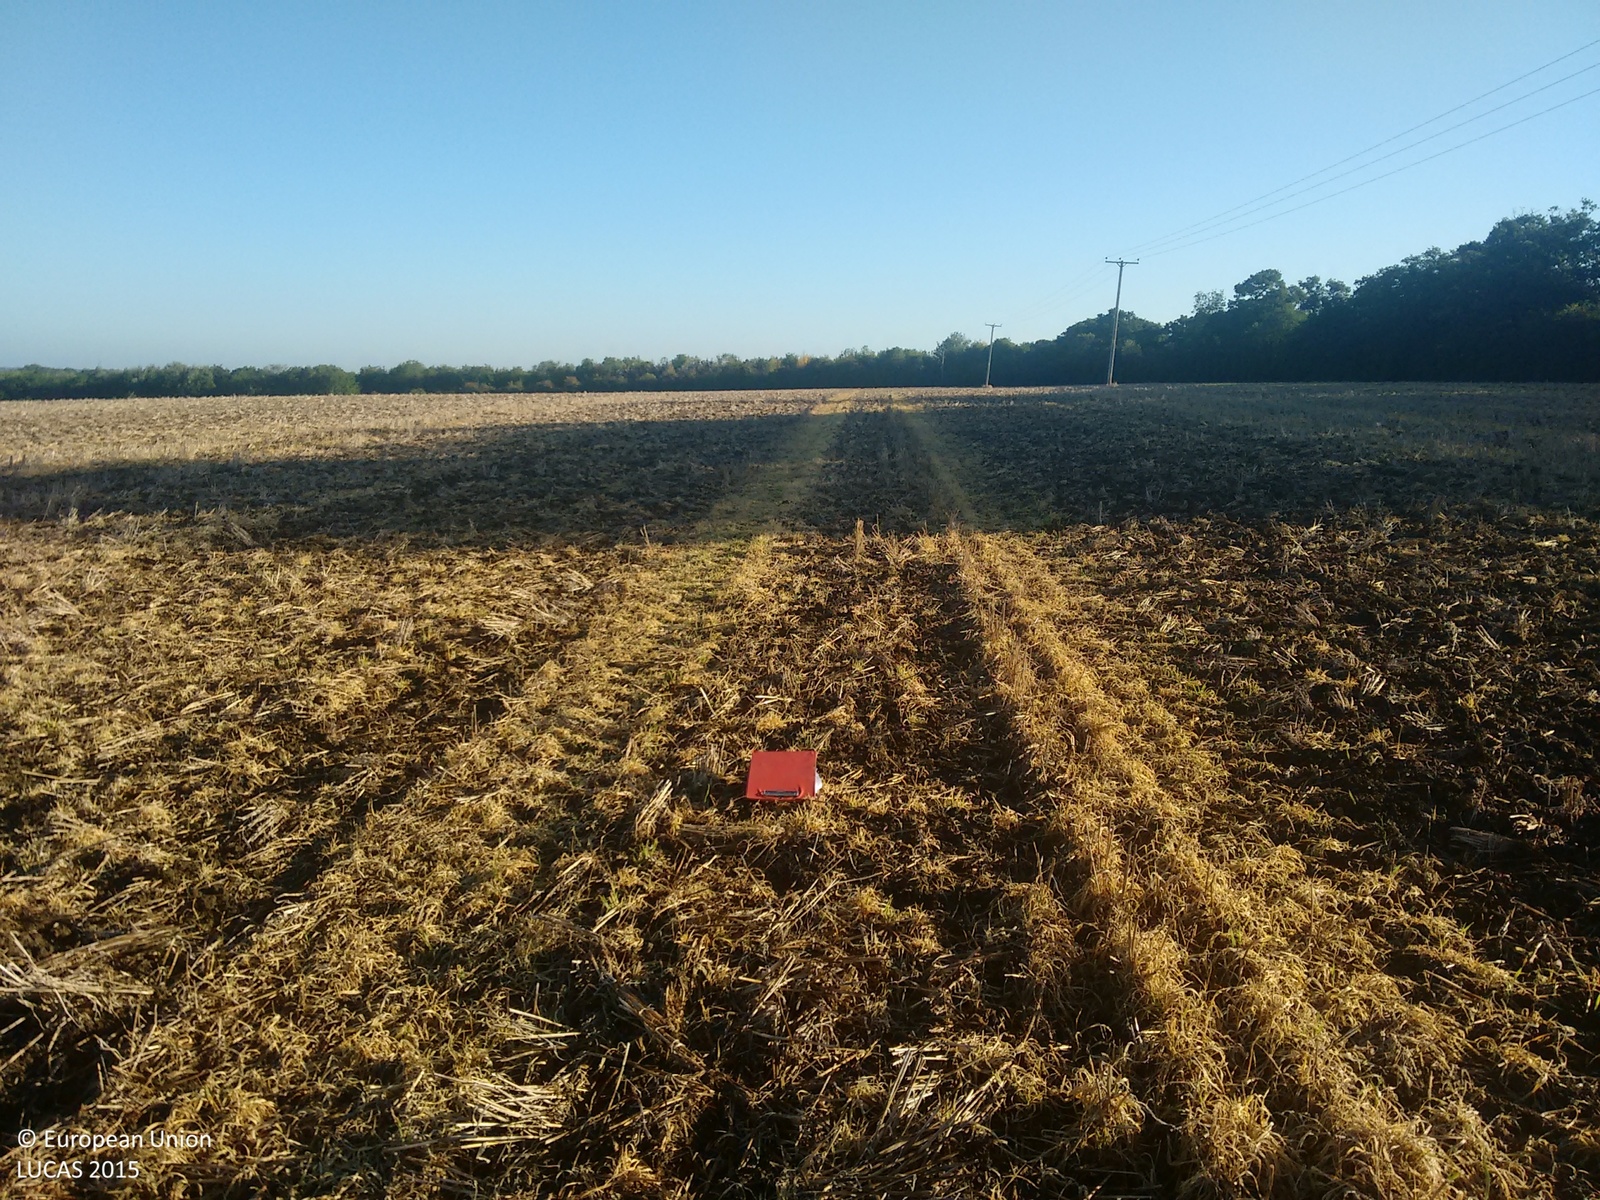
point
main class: Cropland
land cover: Common wheat
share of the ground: 25 - 50 %
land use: Agriculture (excluding fallow land and kitchen gardens)
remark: Harvested field
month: September
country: GB
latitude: 52.2460
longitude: 0.0227
